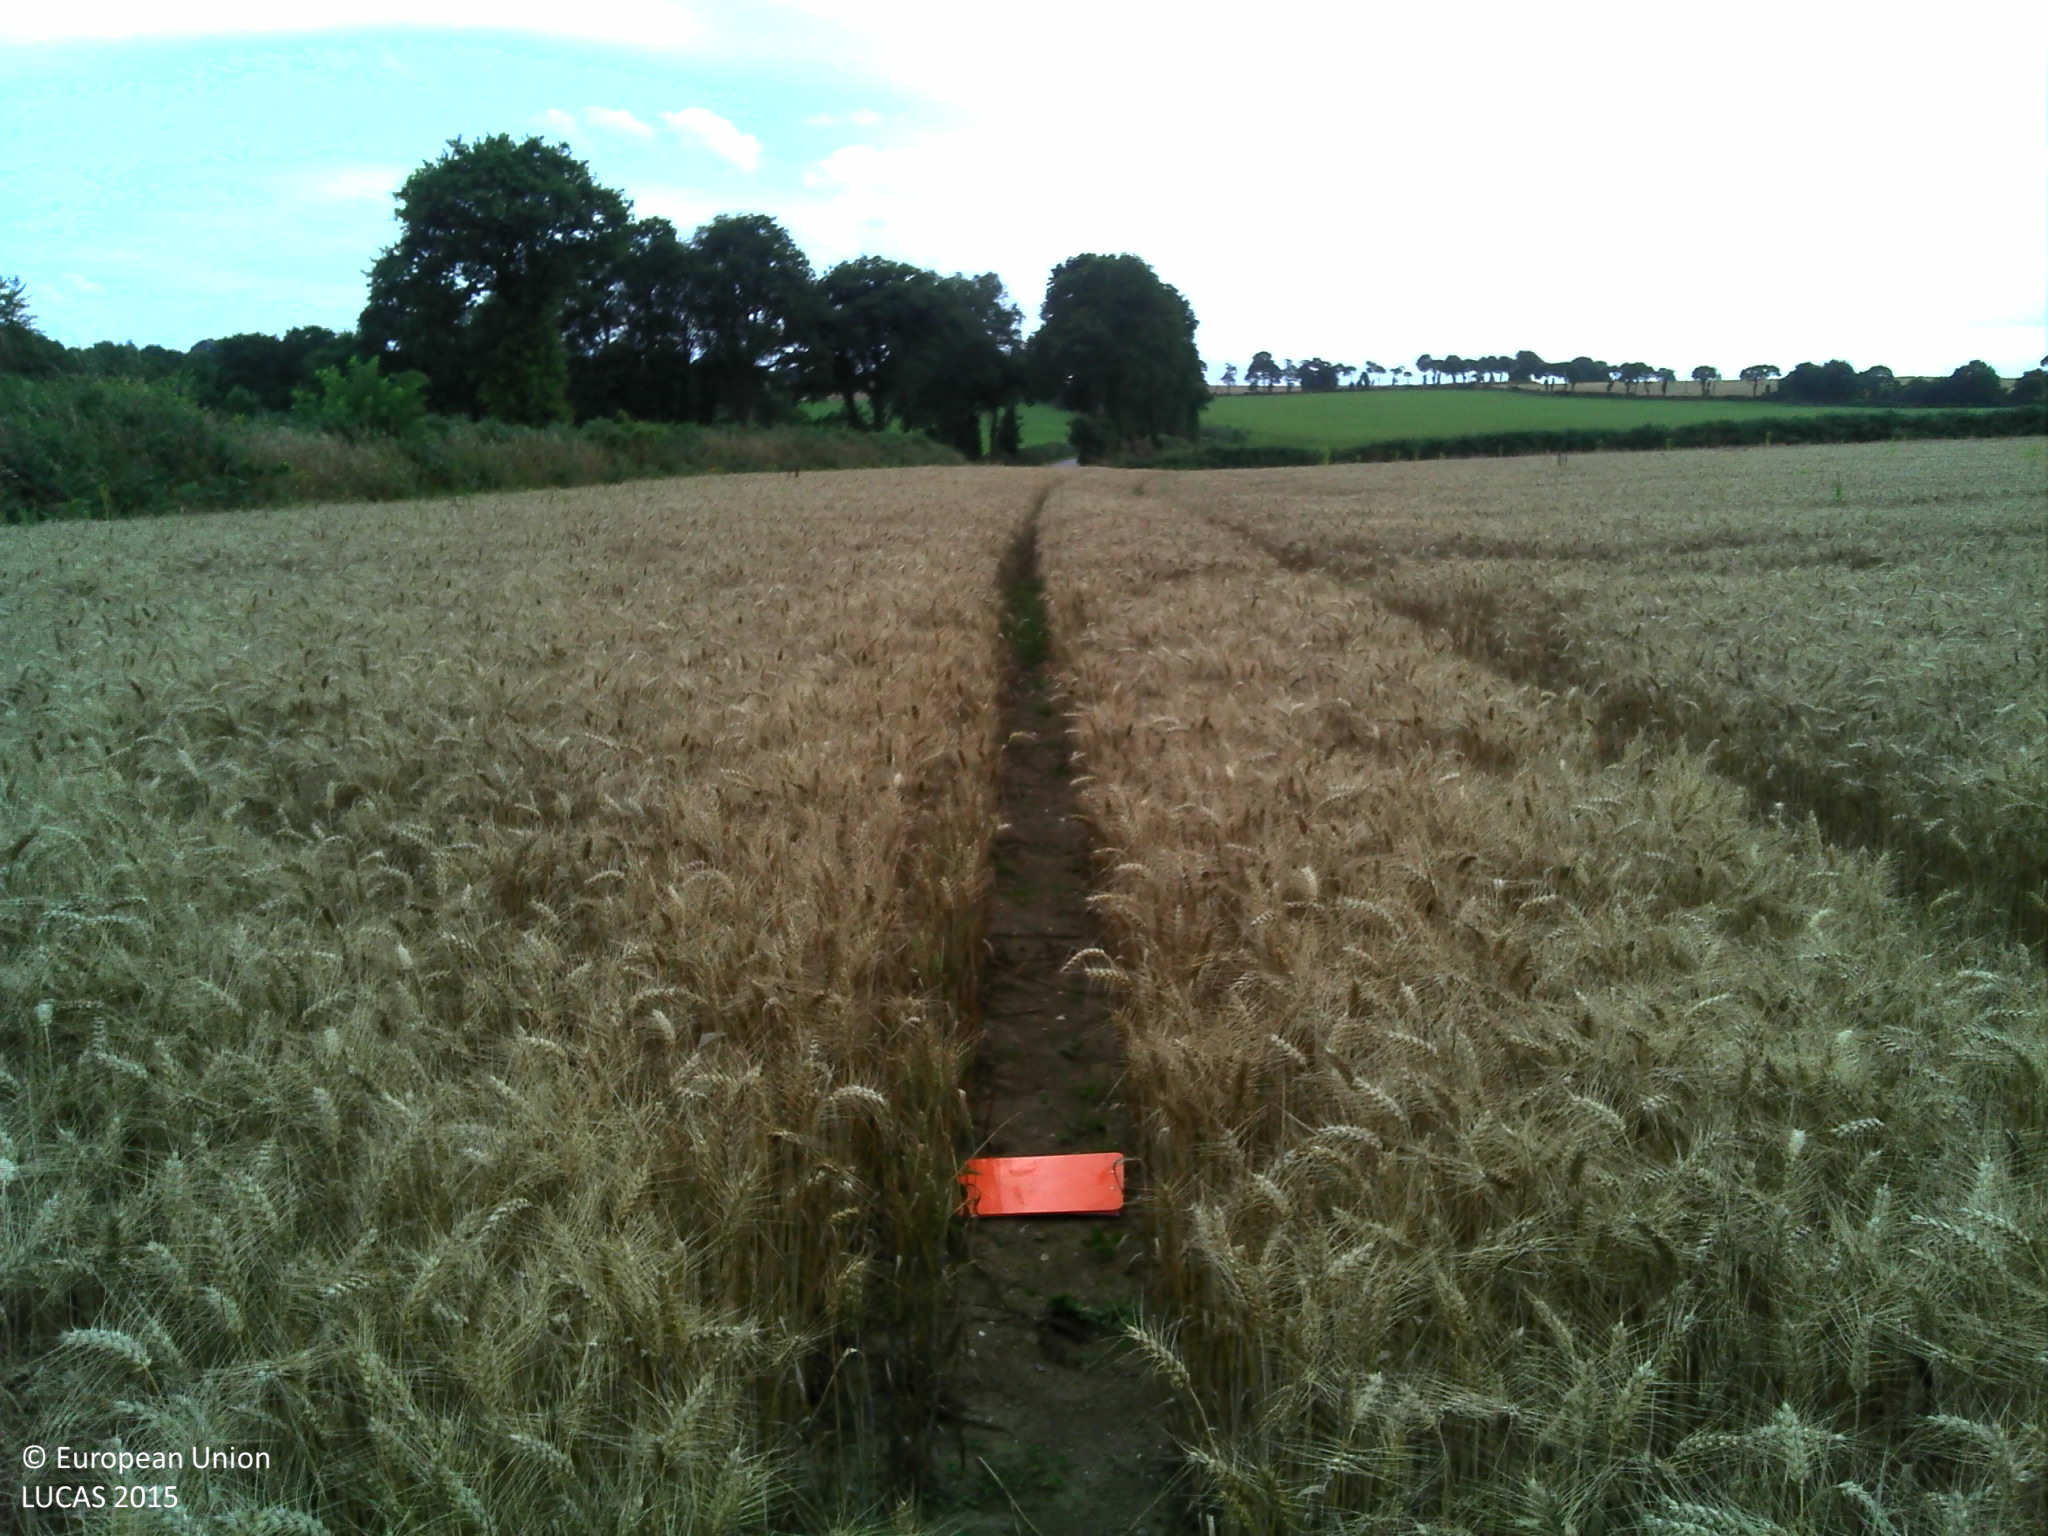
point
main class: Cropland
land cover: Common wheat
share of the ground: > 75 %
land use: Agriculture (excluding fallow land and kitchen gardens)
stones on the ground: 25 - 50 %
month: August
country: FR
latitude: 48.2601
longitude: -3.2336
